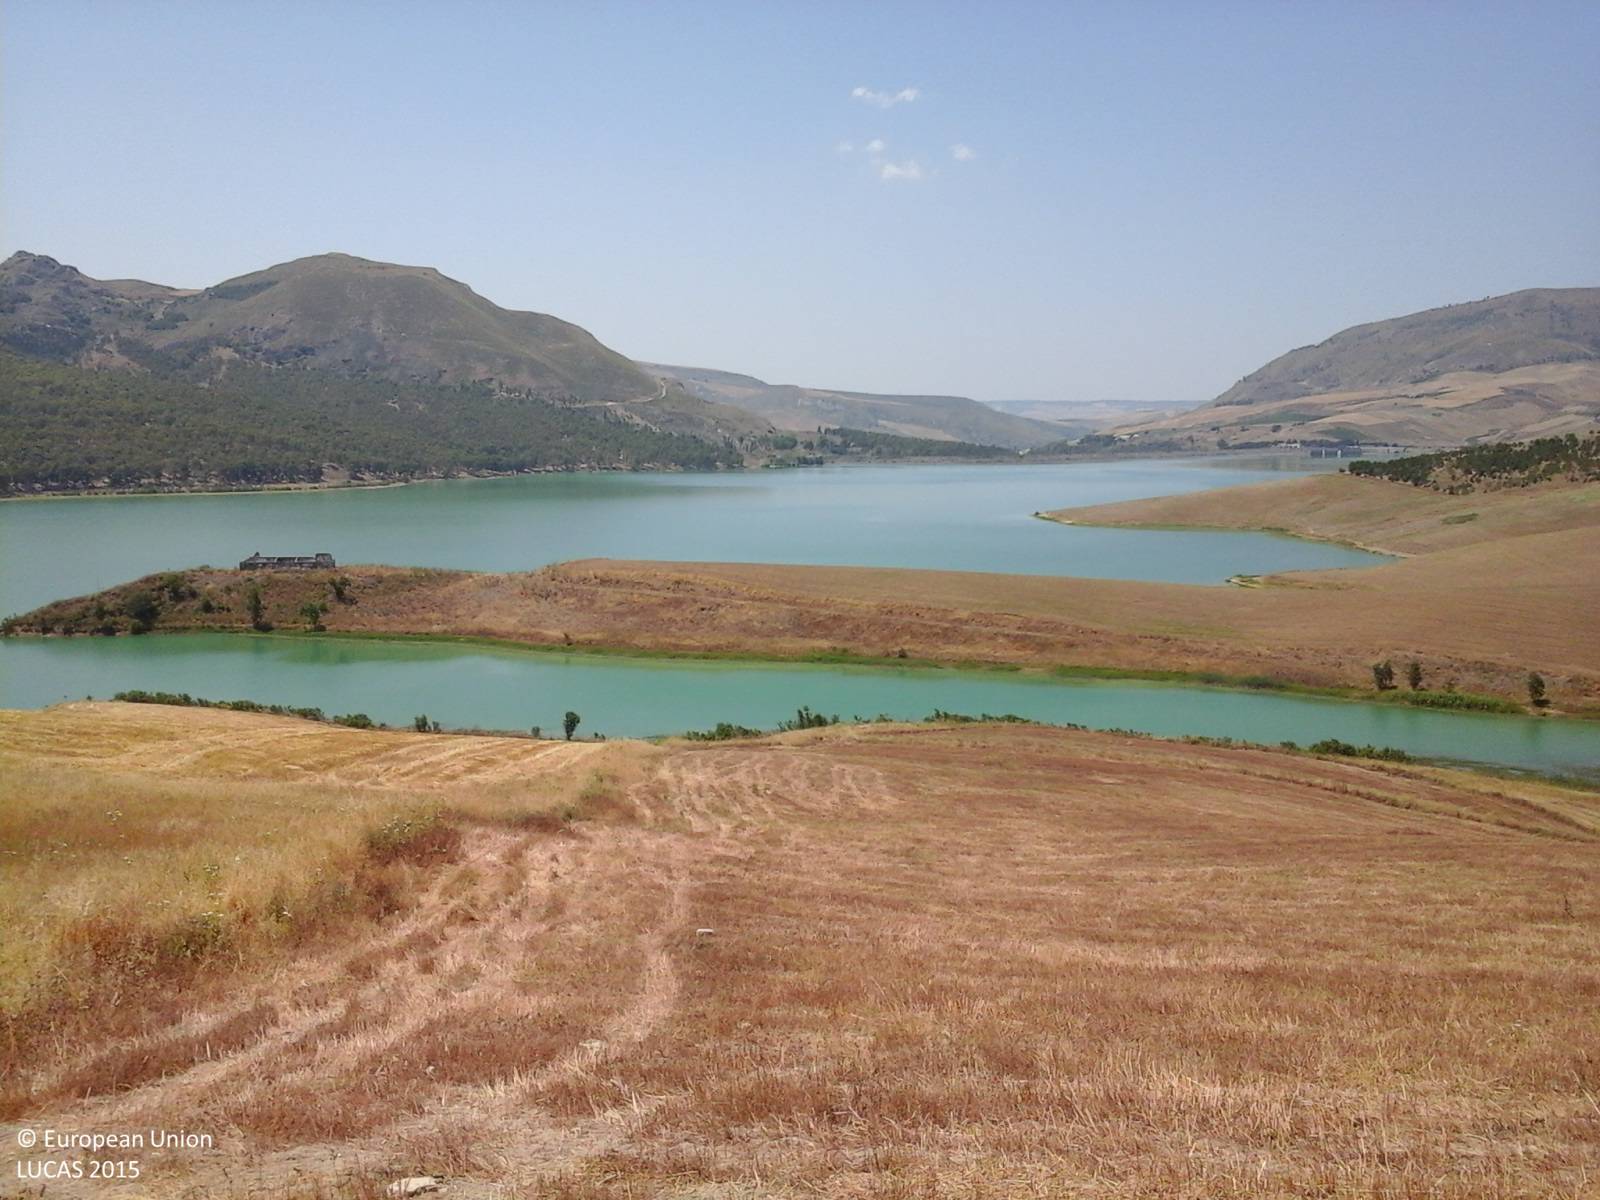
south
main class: Cropland
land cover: Other leguminous and mixtures for fodder
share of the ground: > 75 %
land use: Agriculture (excluding fallow land and kitchen gardens)
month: July
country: IT
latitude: 37.8053
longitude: 13.1232
